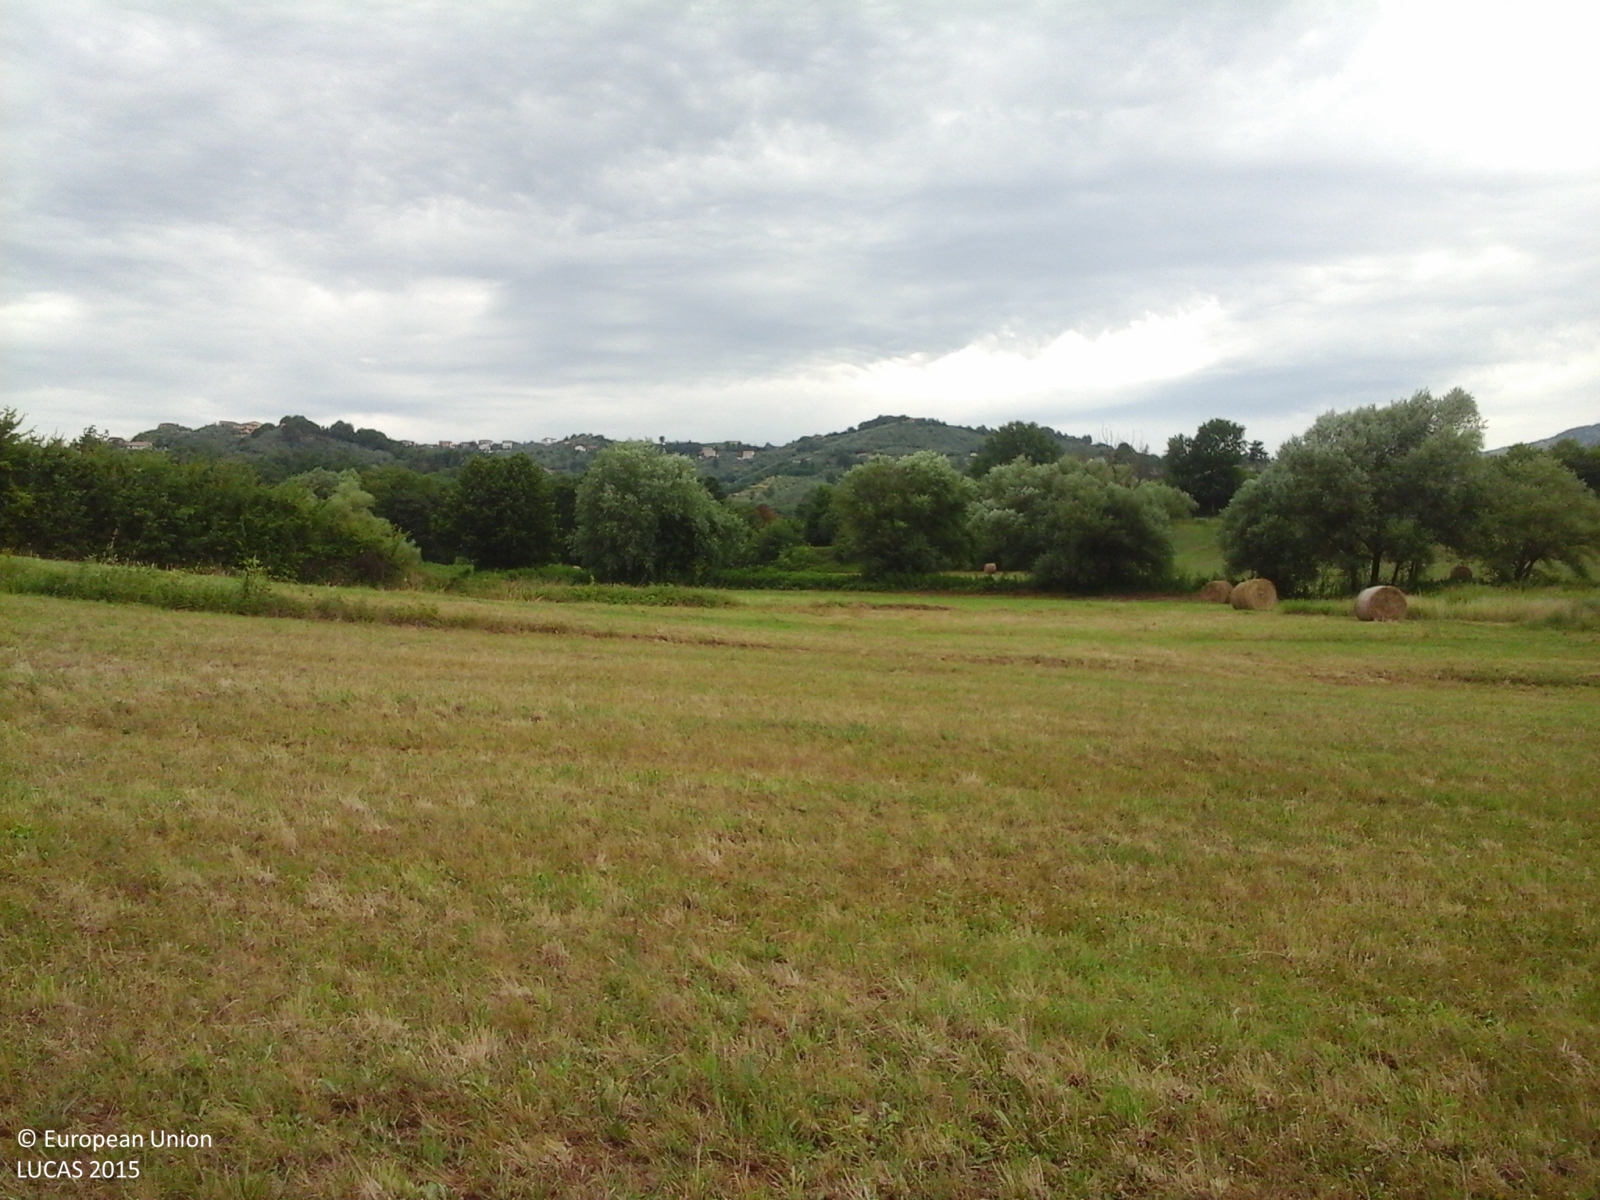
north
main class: Grassland
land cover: Spontaneously vegetated surfaces
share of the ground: > 75 %
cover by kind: herbaceous plants 100 %
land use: Agriculture (excluding fallow land and kitchen gardens)
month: June
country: IT
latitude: 41.7936
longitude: 13.0813
